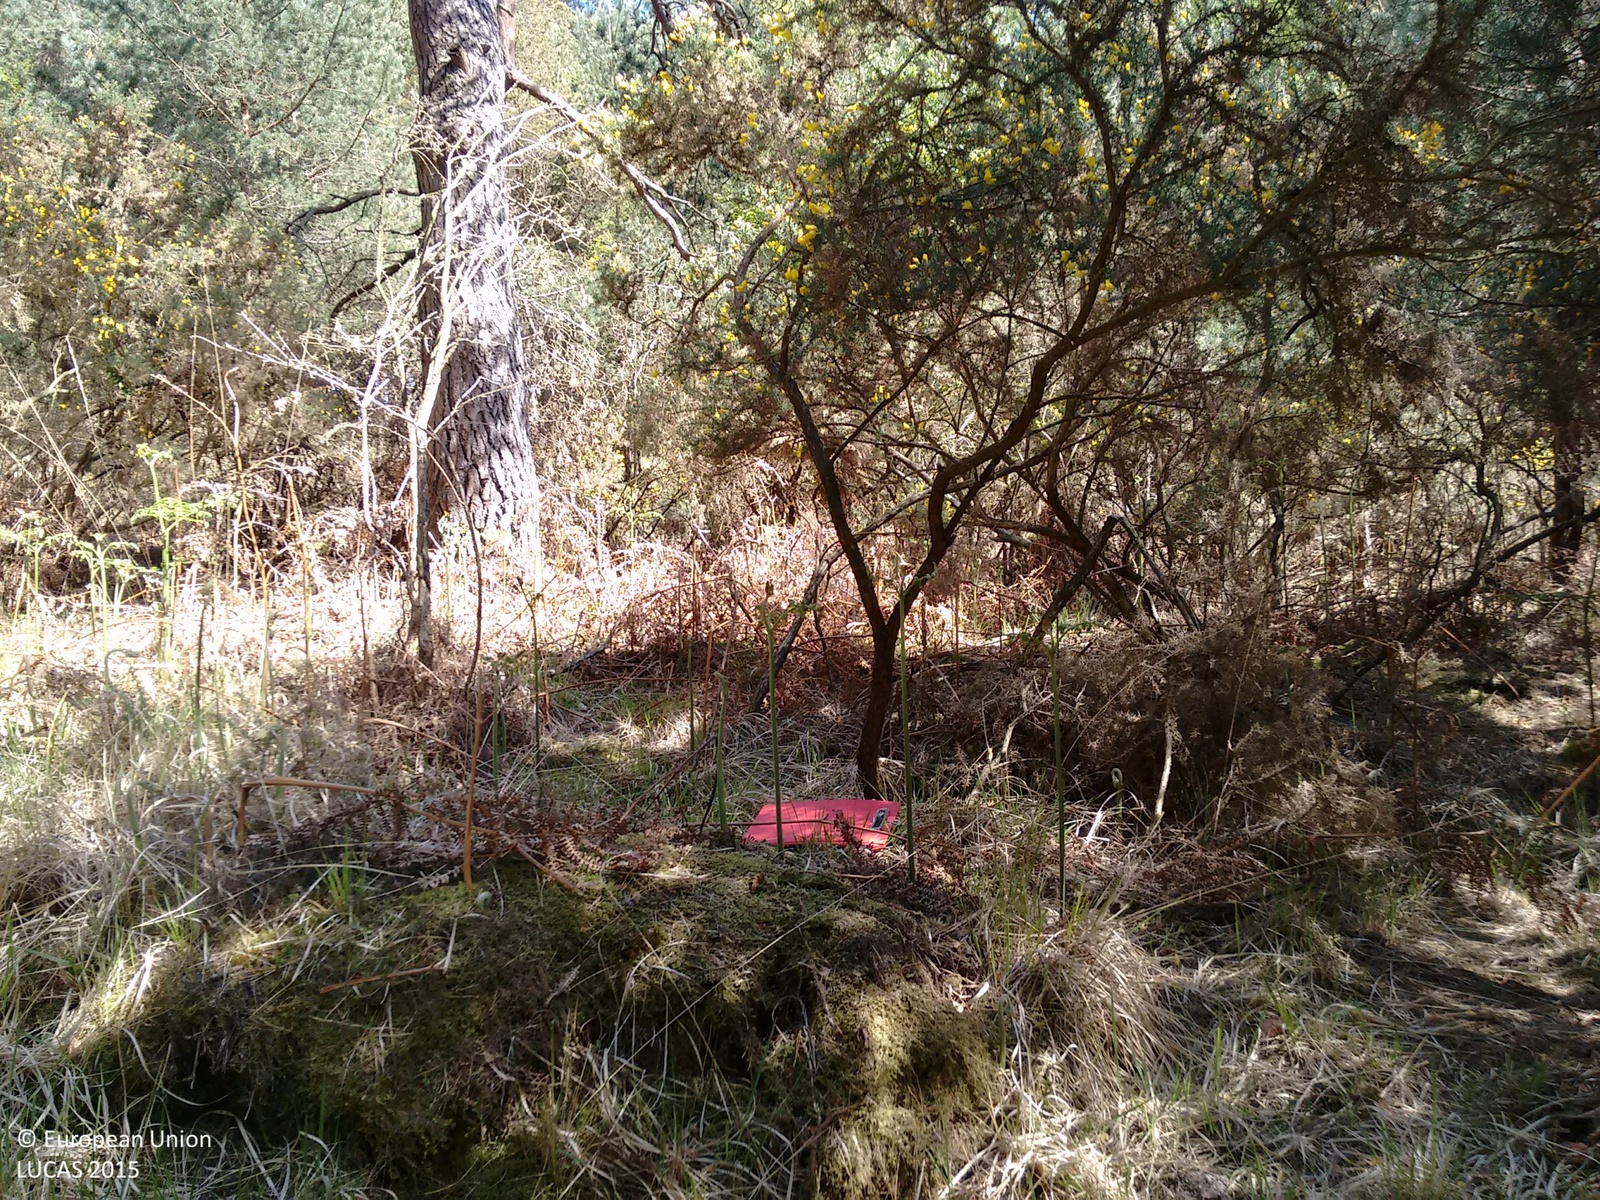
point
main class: Woodland
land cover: Pine dominated mixed woodland
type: hemiboreal forest and nemoral coniferous forest and mixed broadleaved-coniferous forest
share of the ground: > 75 %
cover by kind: coniferous forest trees 70 %, broadleaved forest trees 25 %, shrubs 5 %
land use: Forestry
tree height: > 5 m
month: May
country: GB
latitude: 50.6469
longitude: -2.0947
